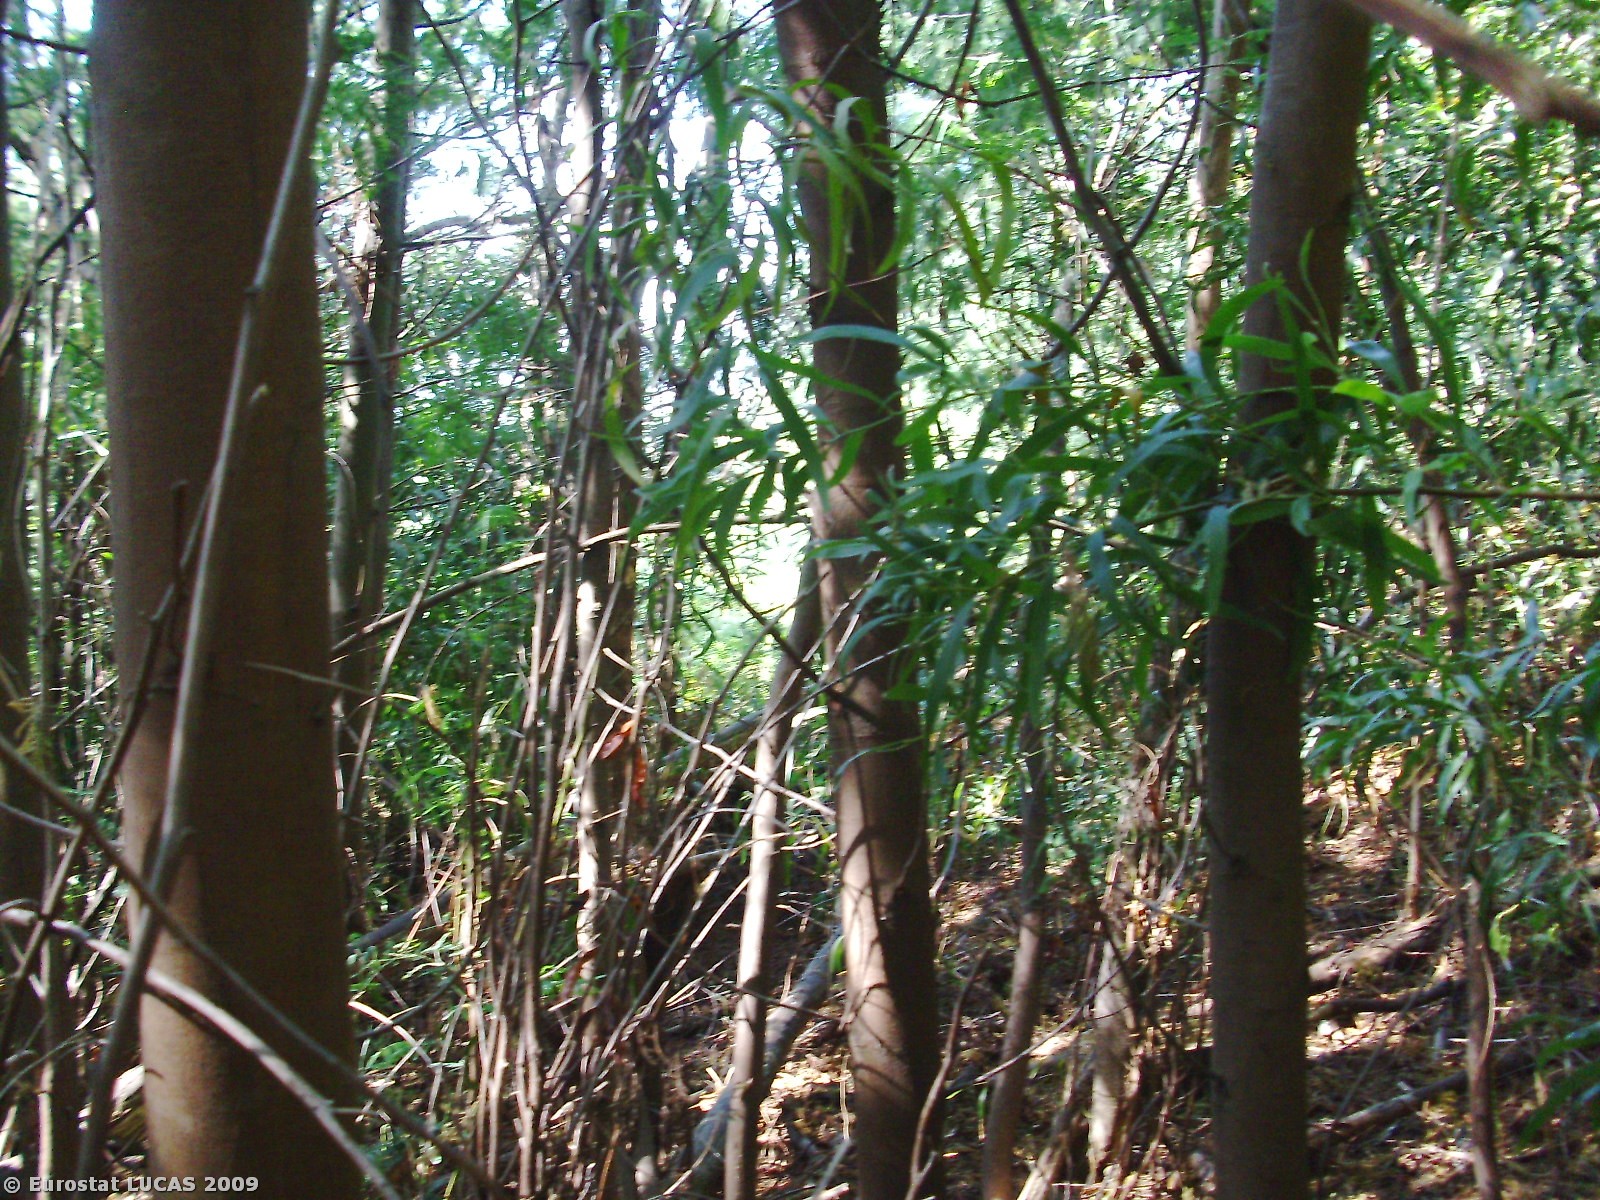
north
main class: Woodland
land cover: Broadleaved woodland
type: mesophytic deciduous forest
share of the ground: > 75 %
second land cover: Shrubland with sparse tree cover
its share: 10 - 25 %
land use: Forestry
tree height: > 5 m
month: August
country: PT
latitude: 40.1193
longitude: -8.2044
